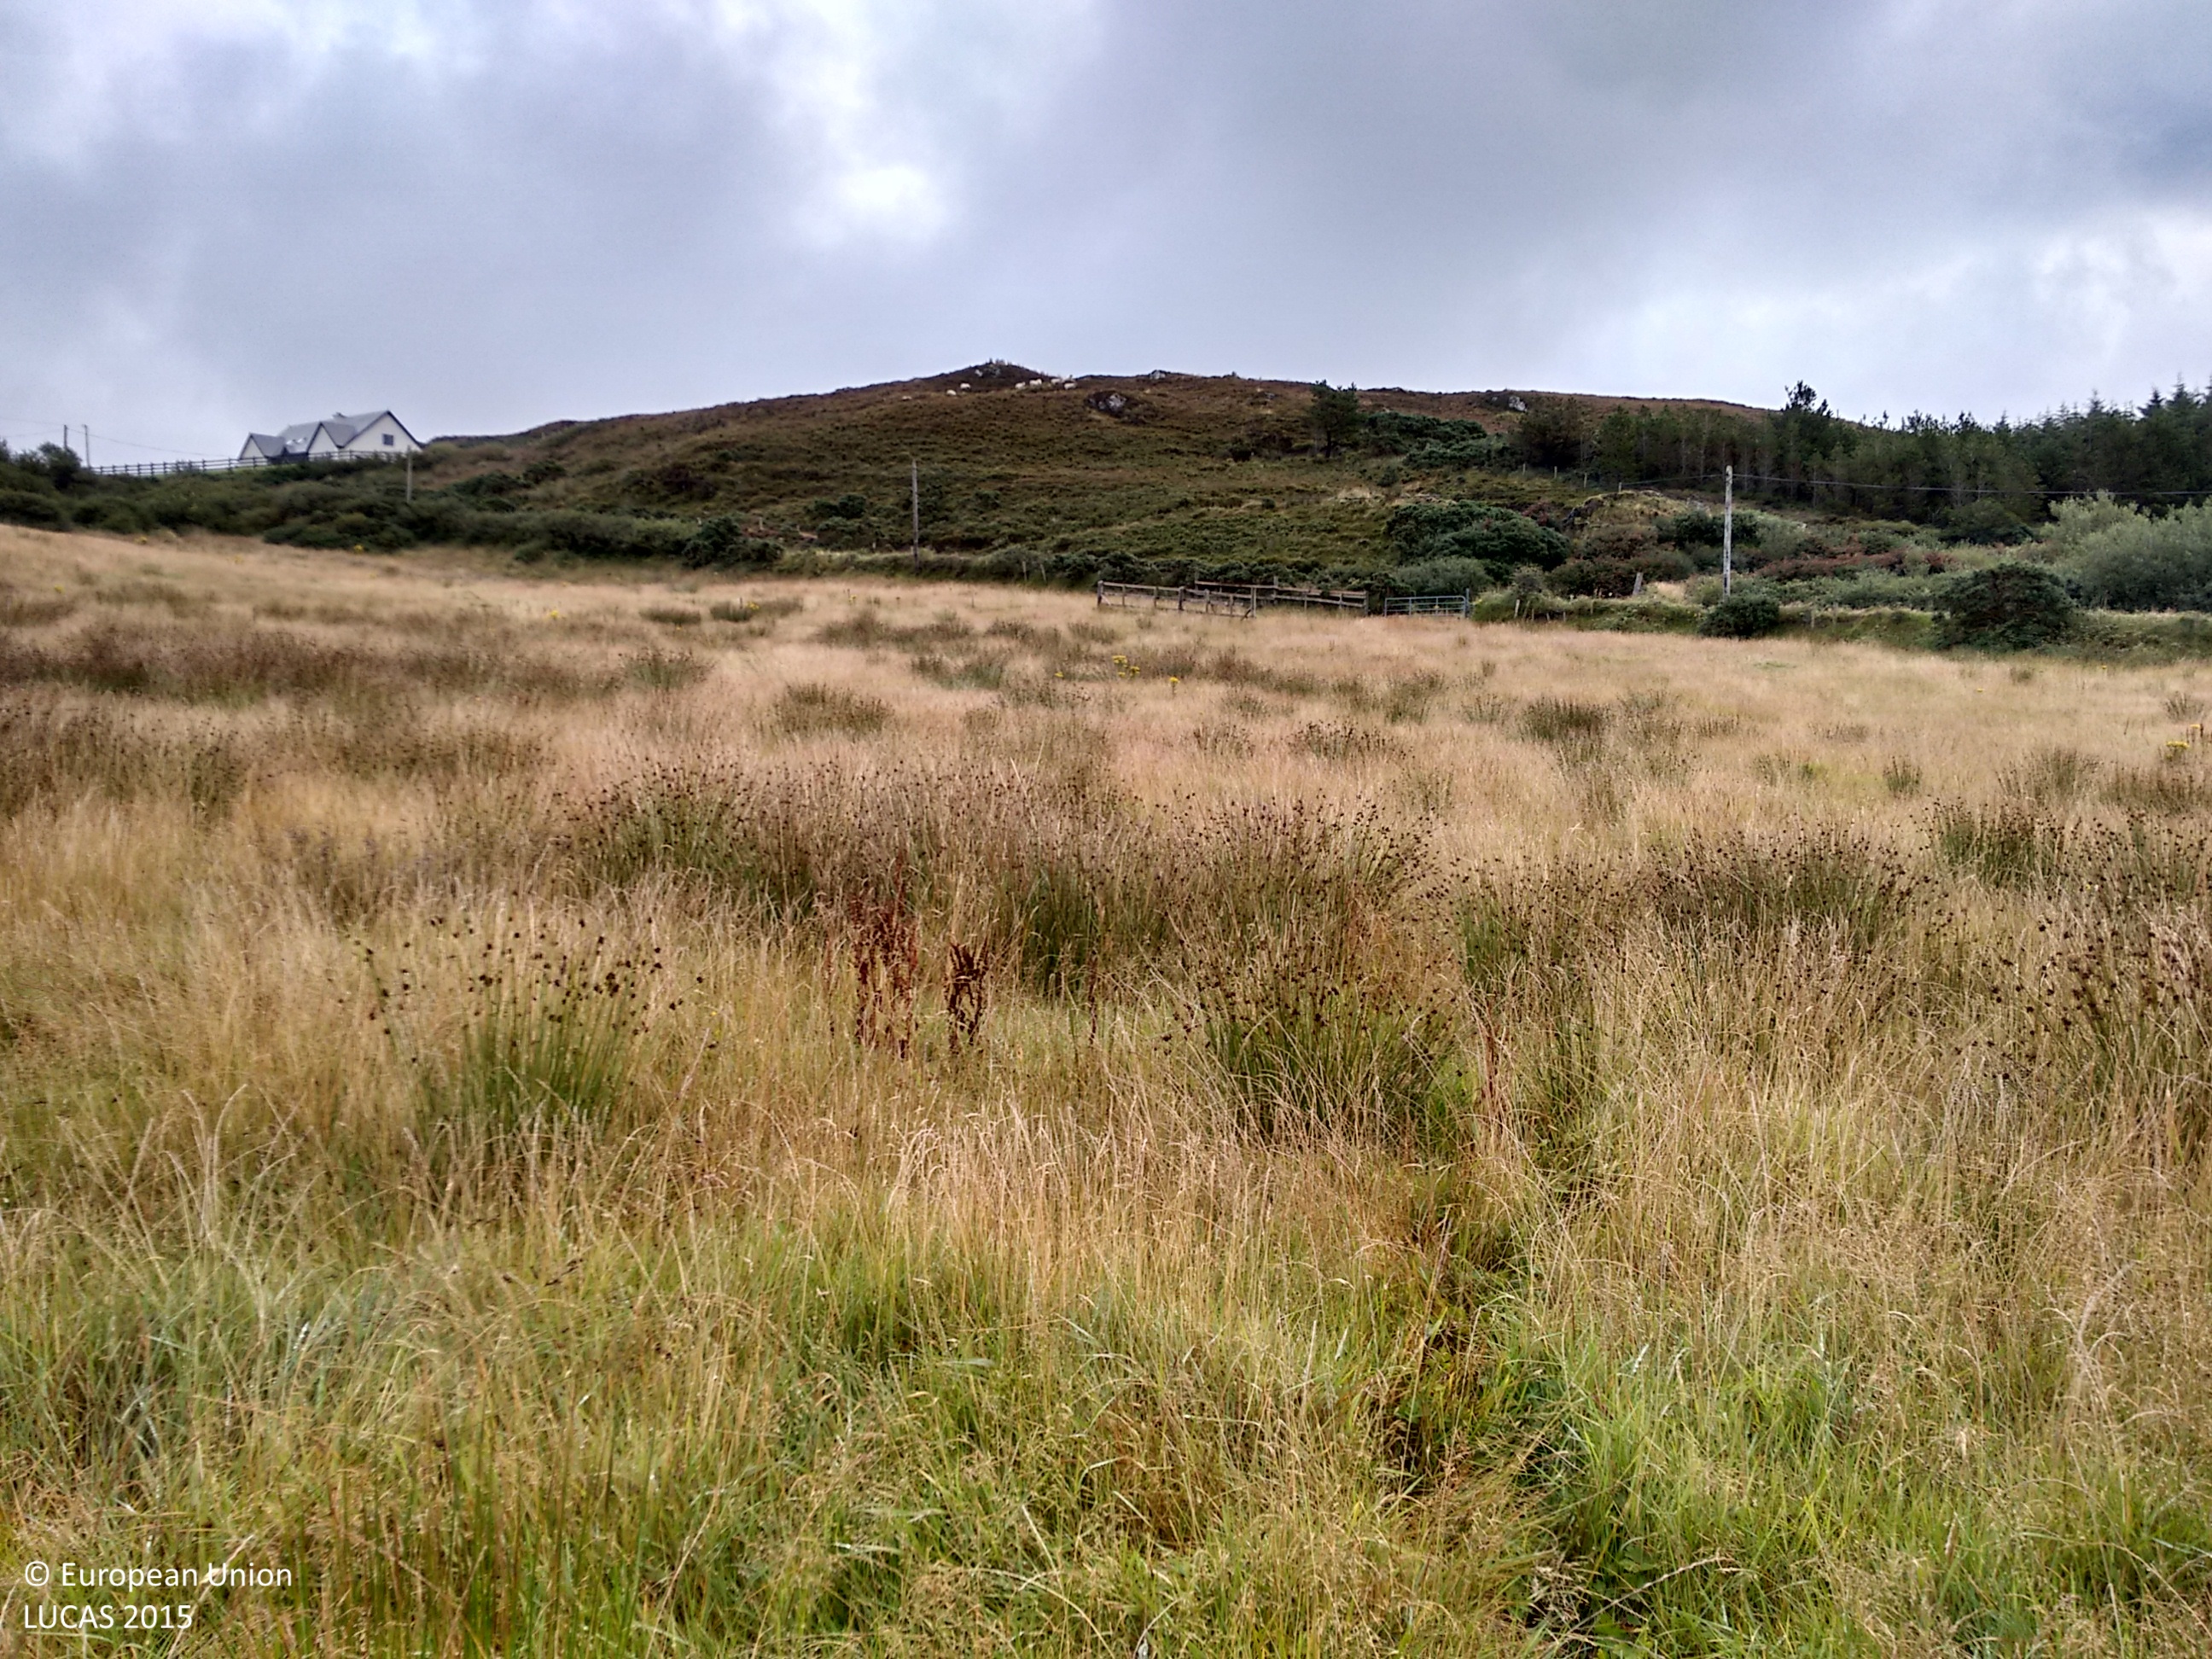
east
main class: Grassland
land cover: Grassland without tree/shrub cover
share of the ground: > 75 %
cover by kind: herbaceous plants 100 %
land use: Agriculture (excluding fallow land and kitchen gardens)
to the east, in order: Grassland without tree/shrub cover; Electric lines; Abandoned hedges; Fences; Grass margins; Paved roads, cycling and walking lanes; Grass margins; Fences; Shrubland with sparse tree cover; Fences; Grass margins; Paved roads, cycling and walking lanes; Ditches and canals; Abandoned hedges; Fences; Shrubland with sparse tree cover; Peatbogs; Dry stone walls; Shrubland without tree cover
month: September
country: IE
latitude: 55.3159
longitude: -7.2734
